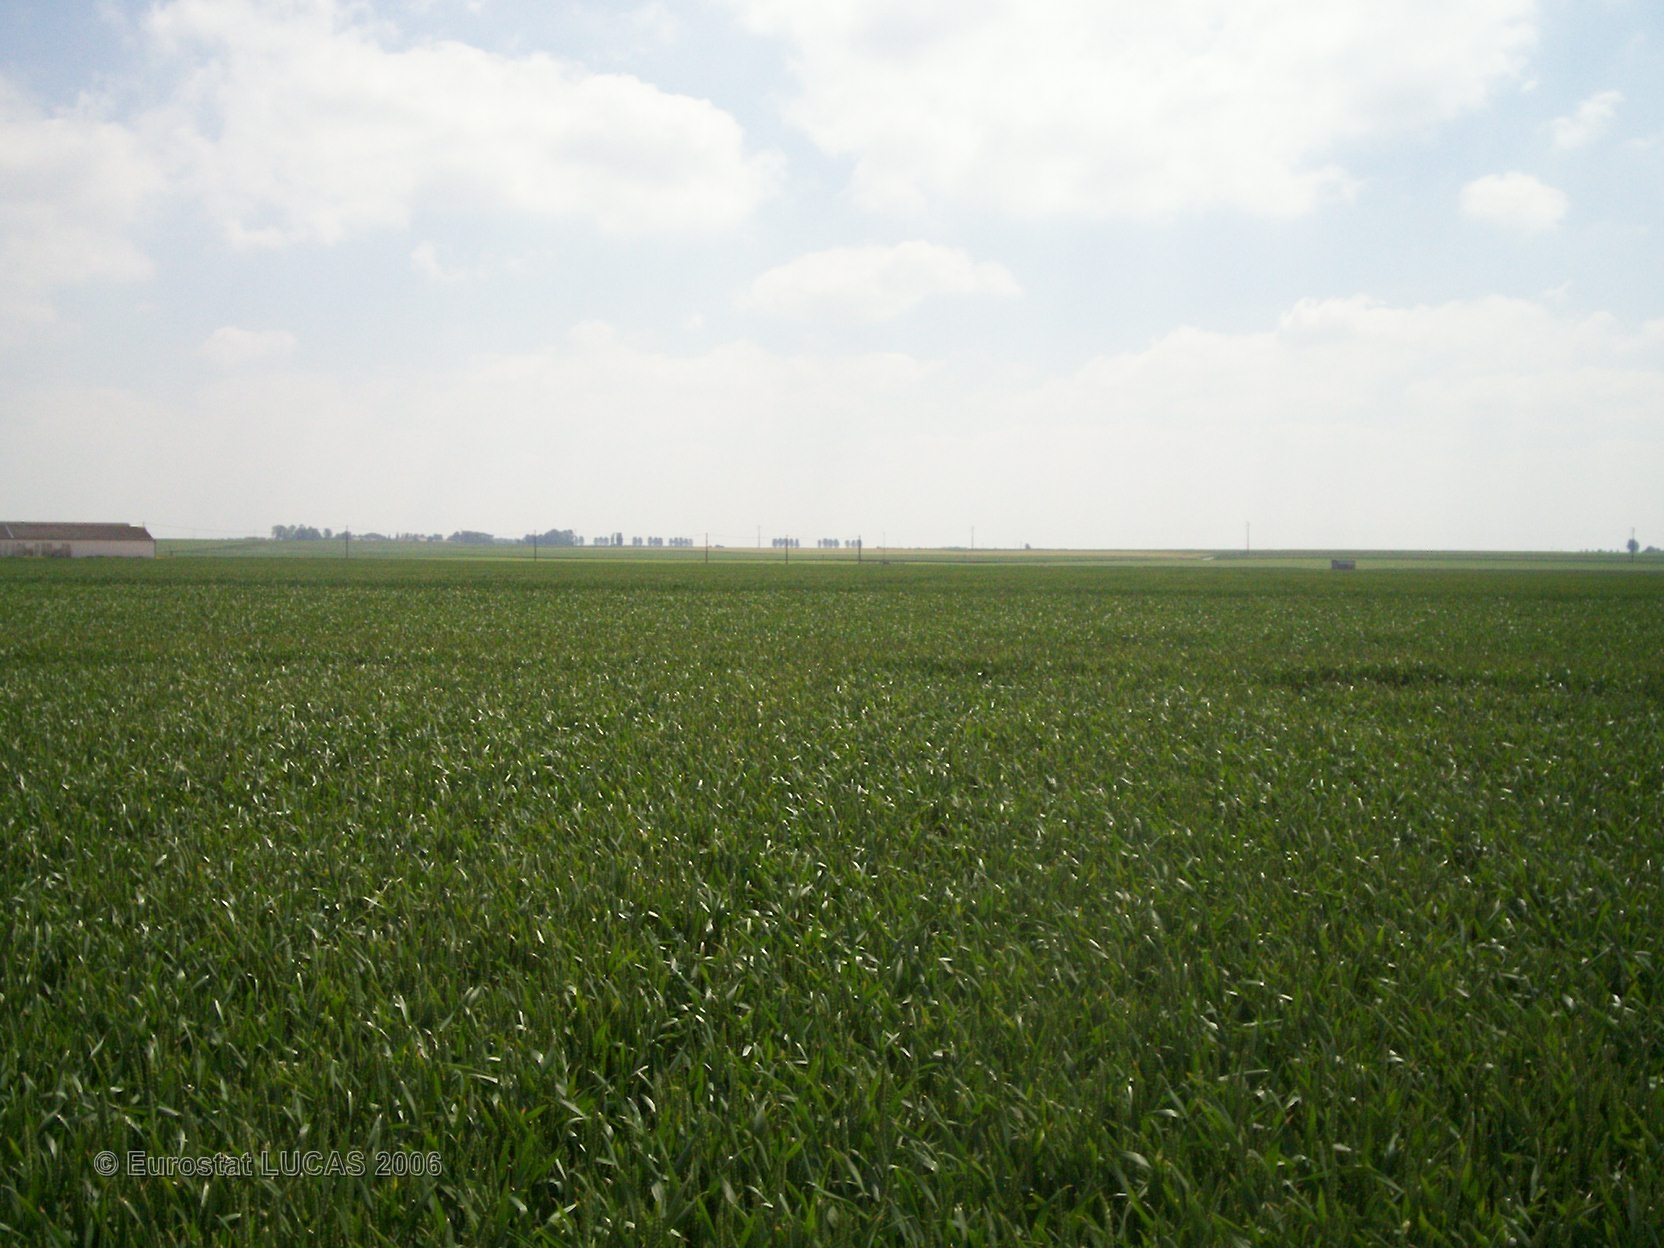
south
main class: Cropland
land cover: Common wheat
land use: Agriculture (excluding fallow land and kitchen gardens)
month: June
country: FR
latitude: 49.7695
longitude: 2.6994
